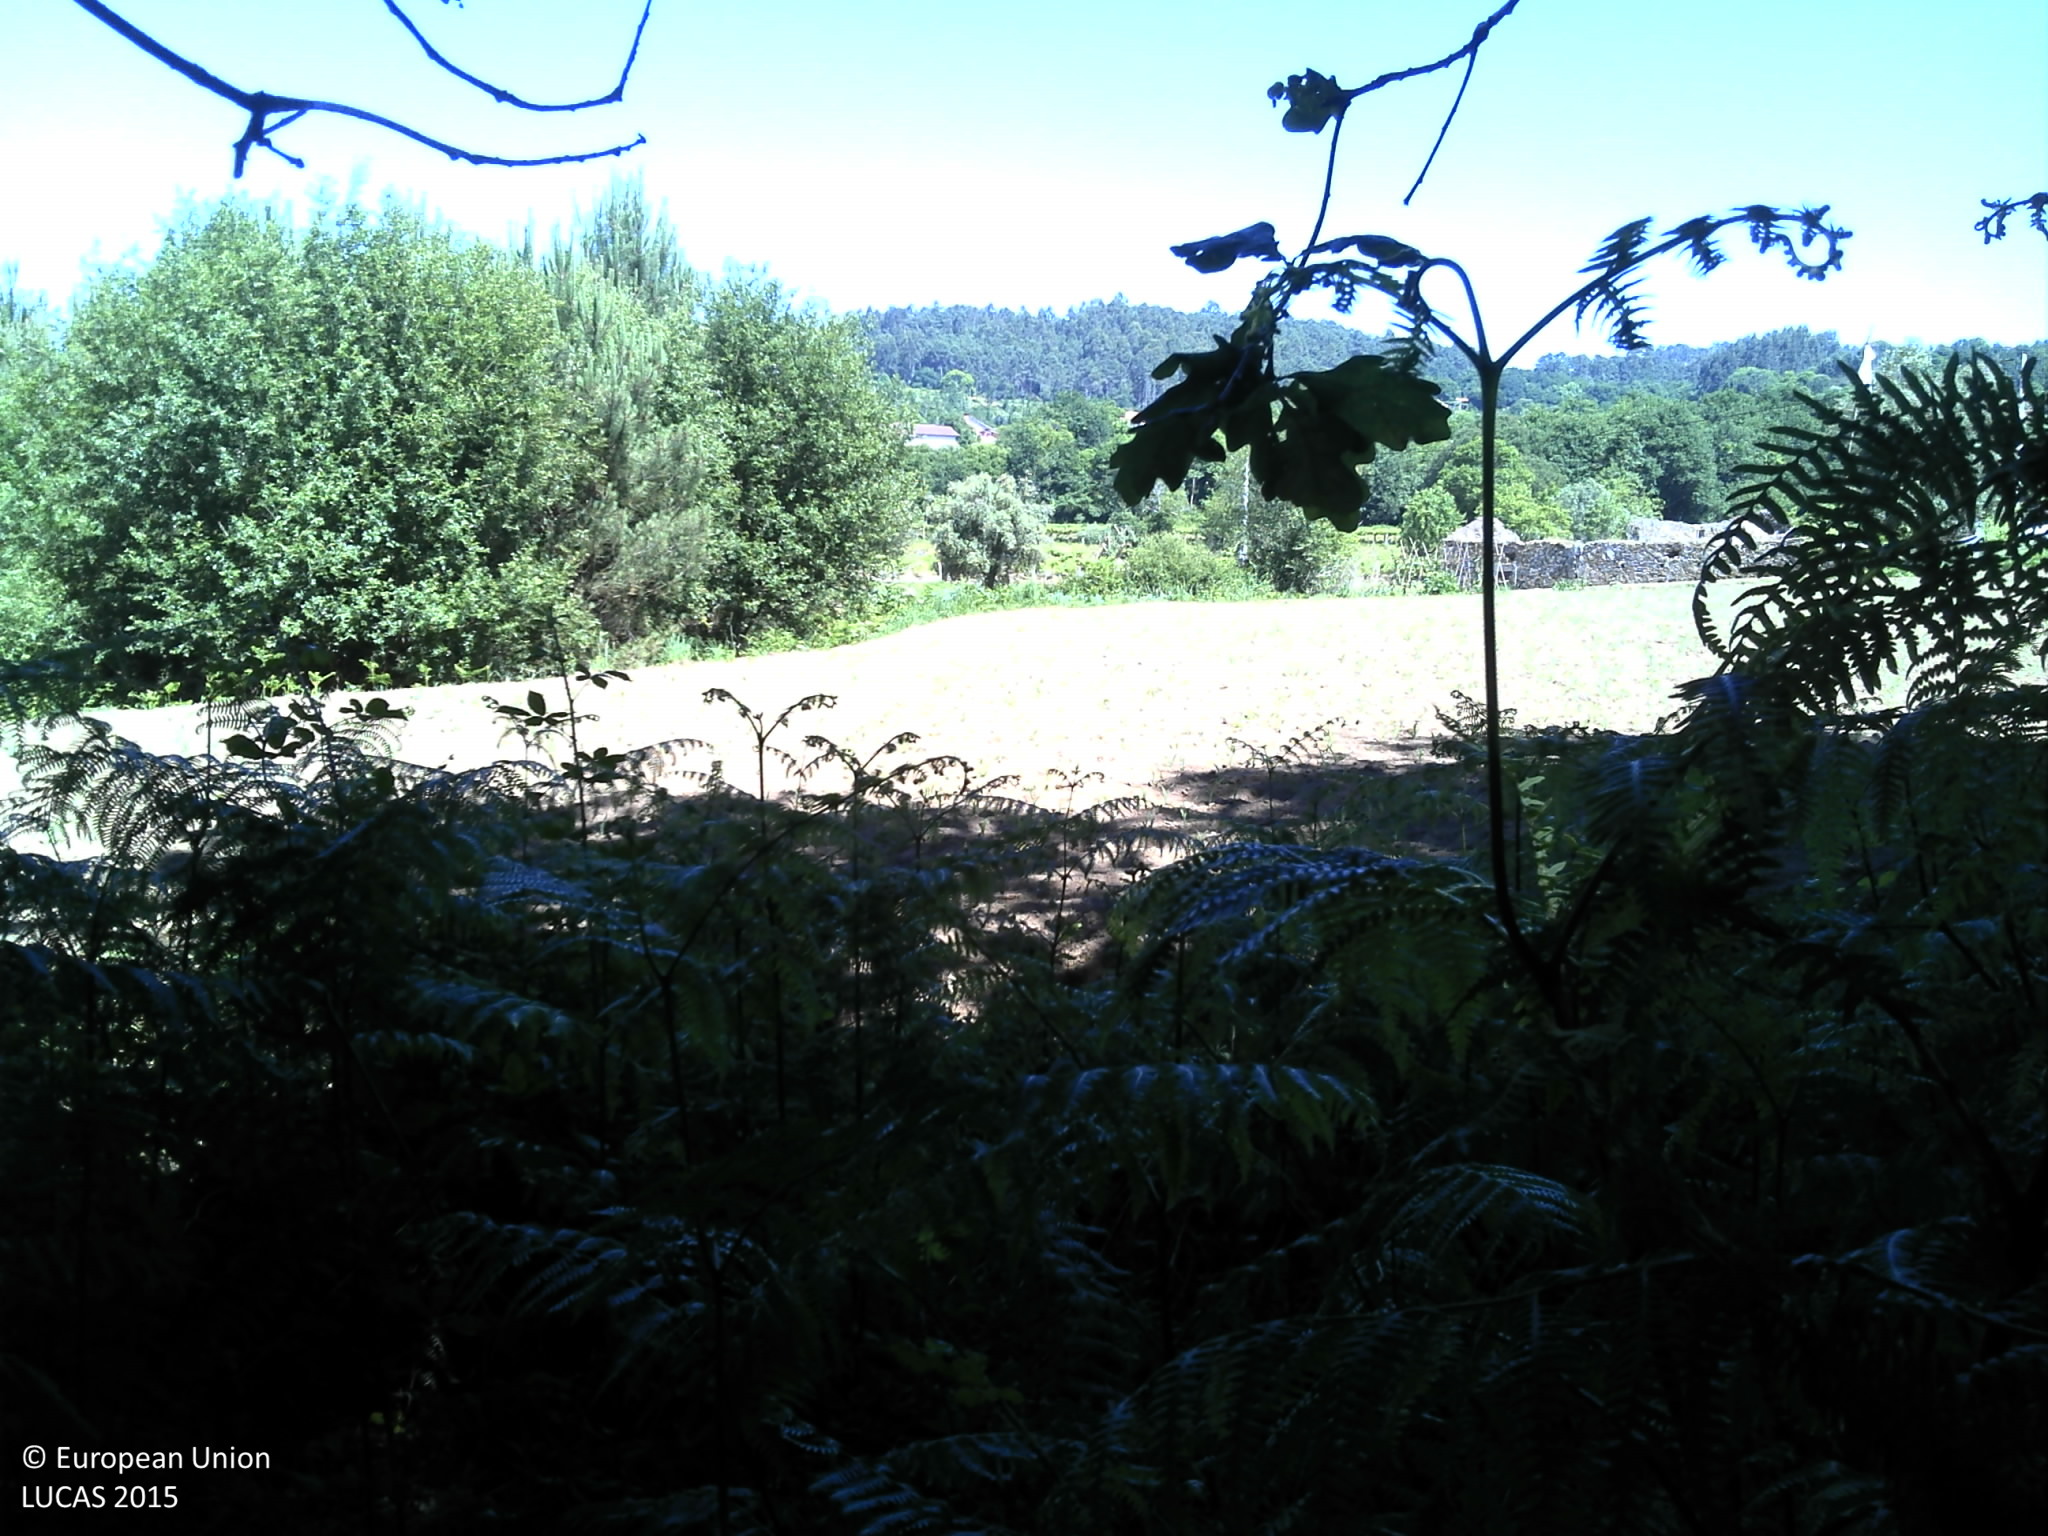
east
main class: Woodland
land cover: Broadleaved woodland
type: thermophilous deciduous forest
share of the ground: > 75 %
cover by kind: broadleaved forest trees 85 %, shrubs 15 %
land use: Forestry
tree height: > 5 m
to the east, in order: Broadleaved woodland; Pine dominated coniferous woodland; Electric lines; Rivers and streams; Grassland without tree/shrub cover; Fences; Grassland without tree/shrub cover; Fences; Electric lines; Paved roads, cycling and walking lanes; Abandoned hedges; Temporary grasslands; Fences; Grassland without tree/shrub cover; Other fruit trees and berries
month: May
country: PT
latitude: 41.9505
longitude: -8.6857
